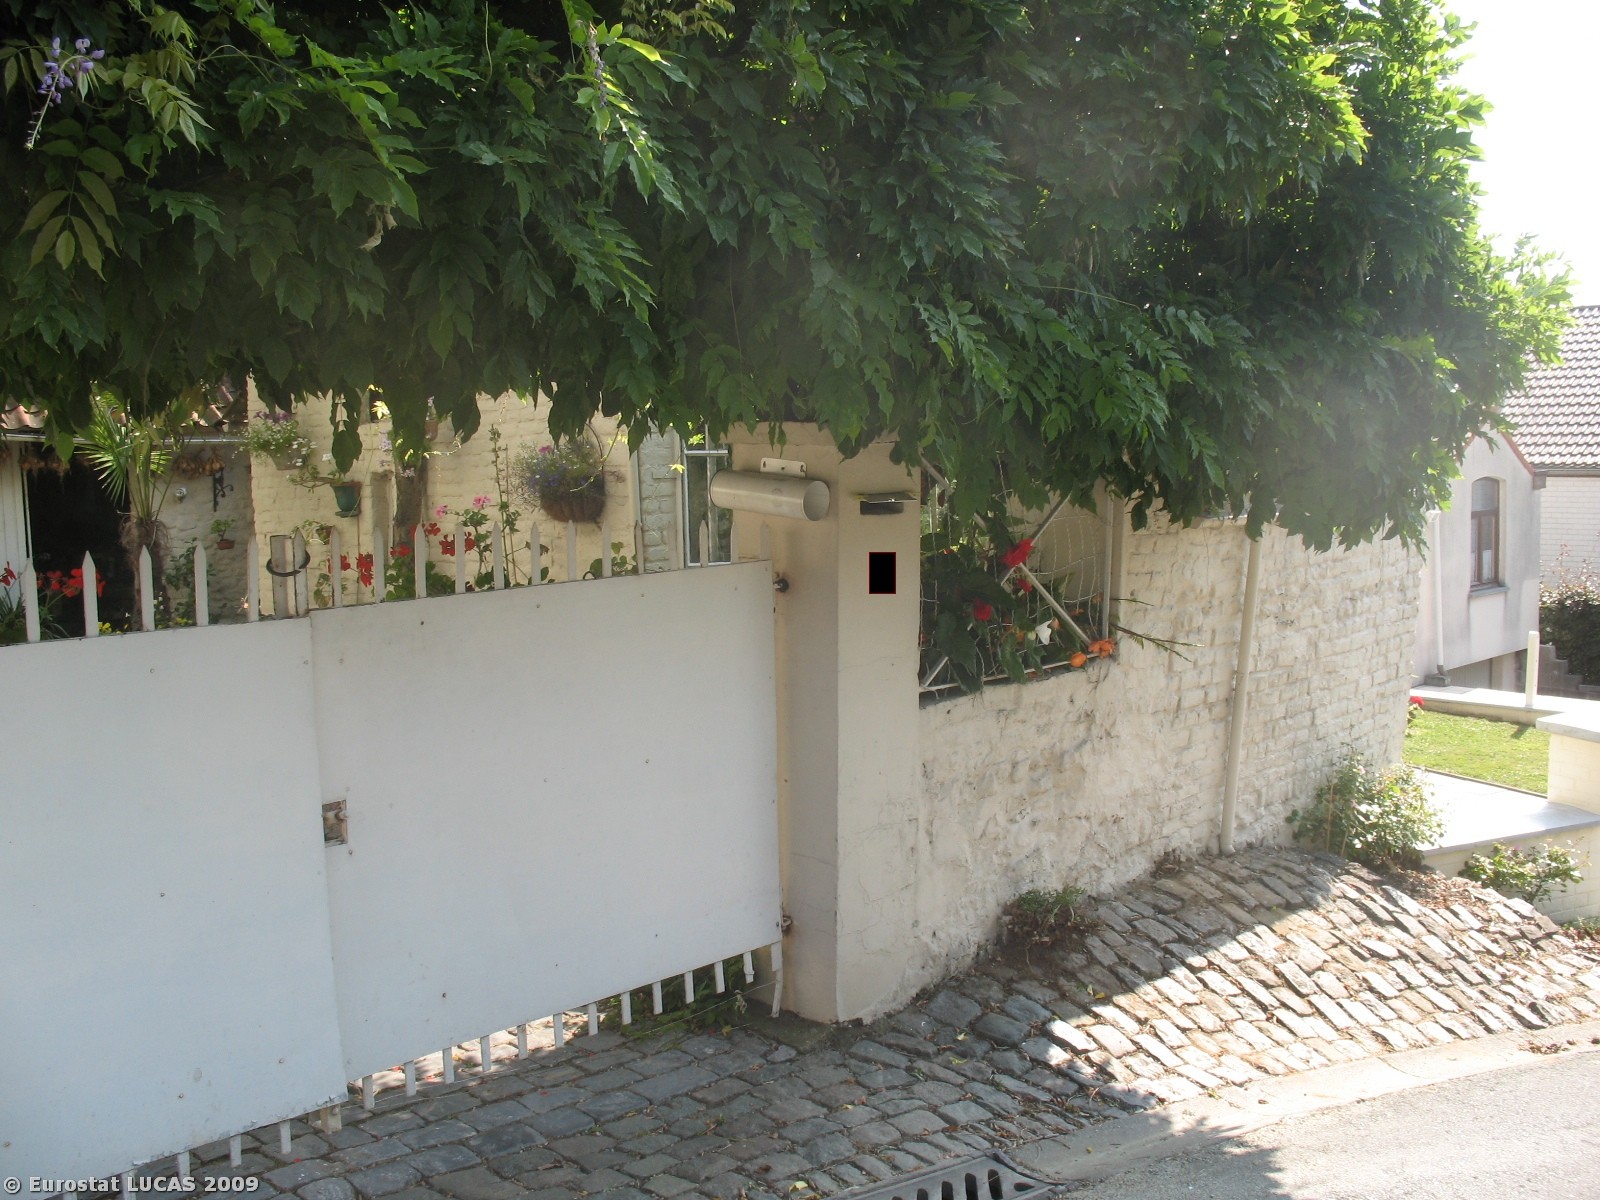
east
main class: Artificial land
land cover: Buildings with 1 to 3 floors
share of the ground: > 75 %
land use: Residential
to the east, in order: Grassland without tree/shrub cover; Conifer hedges; Paved roads, cycling and walking lanes; Artificial constructions in urban areas; Grassland without tree/shrub cover; Artificial constructions in urban areas; Broadleaved woodland; Grassland without tree/shrub cover; Managed hedges; Paved roads, cycling and walking lanes; Grass margins; Fences; Mixed woodland
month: August
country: BE
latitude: 50.6916
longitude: 4.3188
